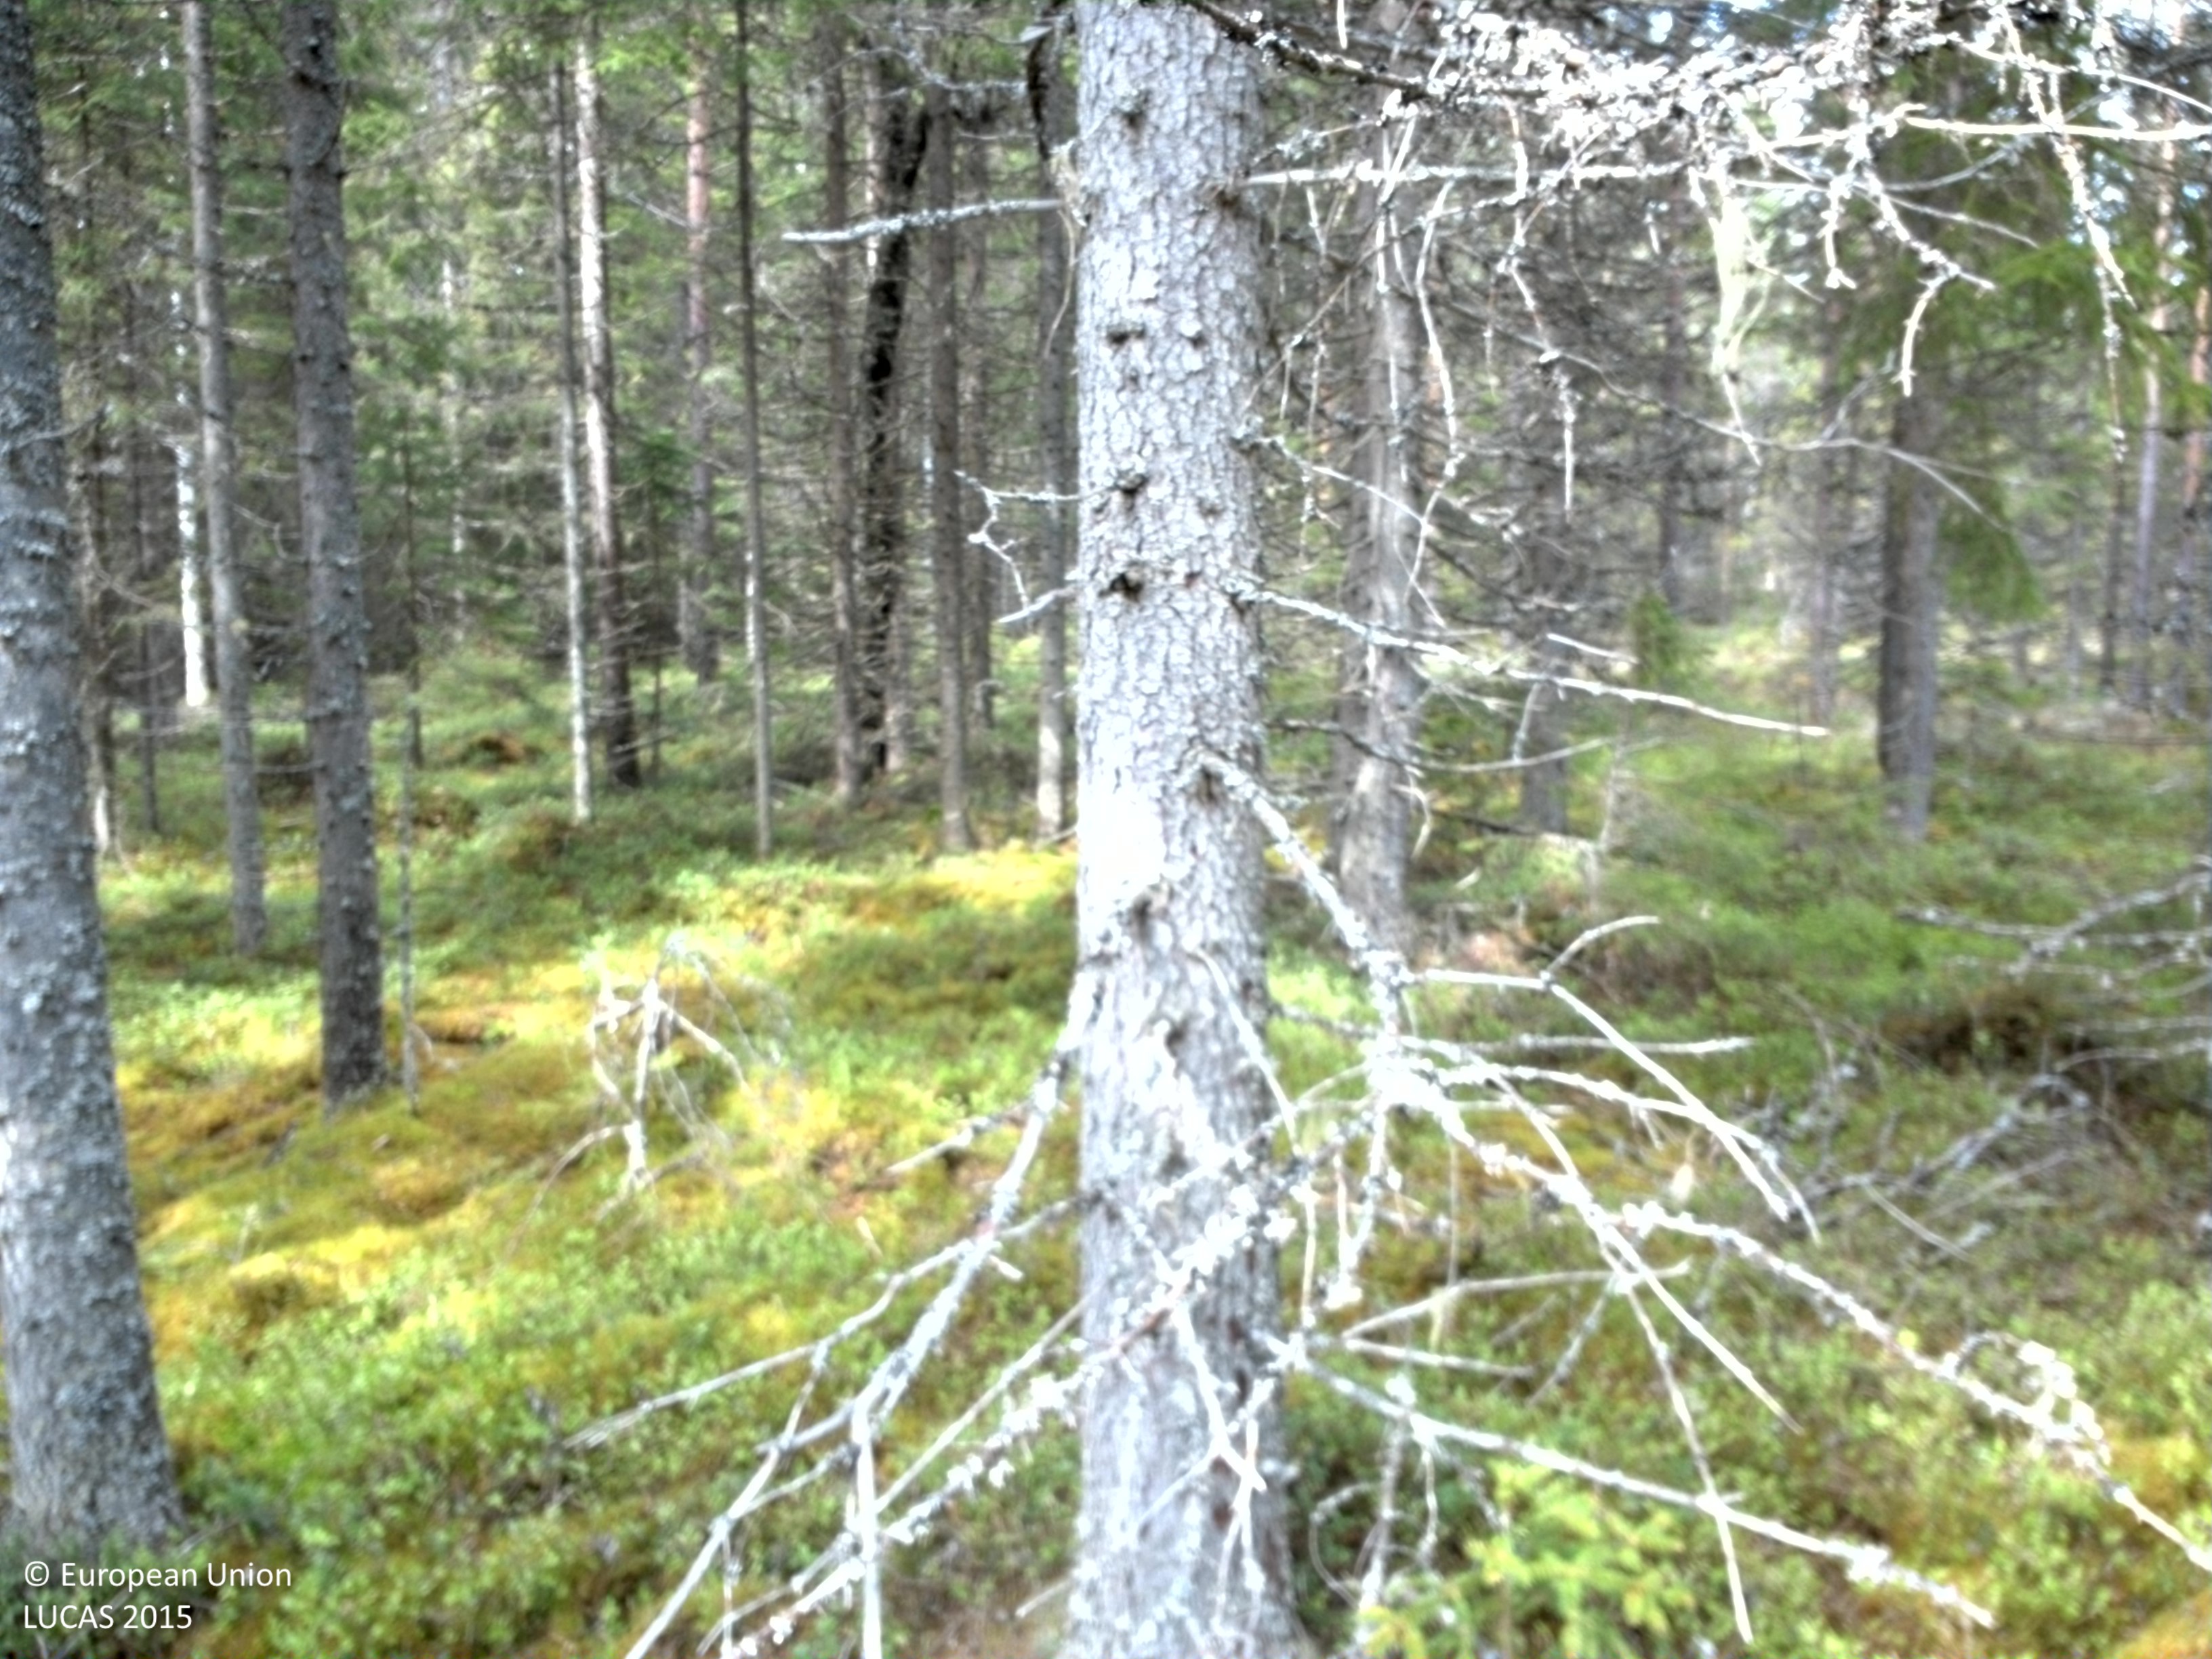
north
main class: Woodland
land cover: Spruce dominated coniferous woodland
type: boreal forest
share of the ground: 50 - 75 %
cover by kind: coniferous forest trees 65 %, shrubs 25 %, lichens and mosses 10 %
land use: Forestry
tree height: > 5 m
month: June
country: SE
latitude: 60.5755
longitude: 13.2564
